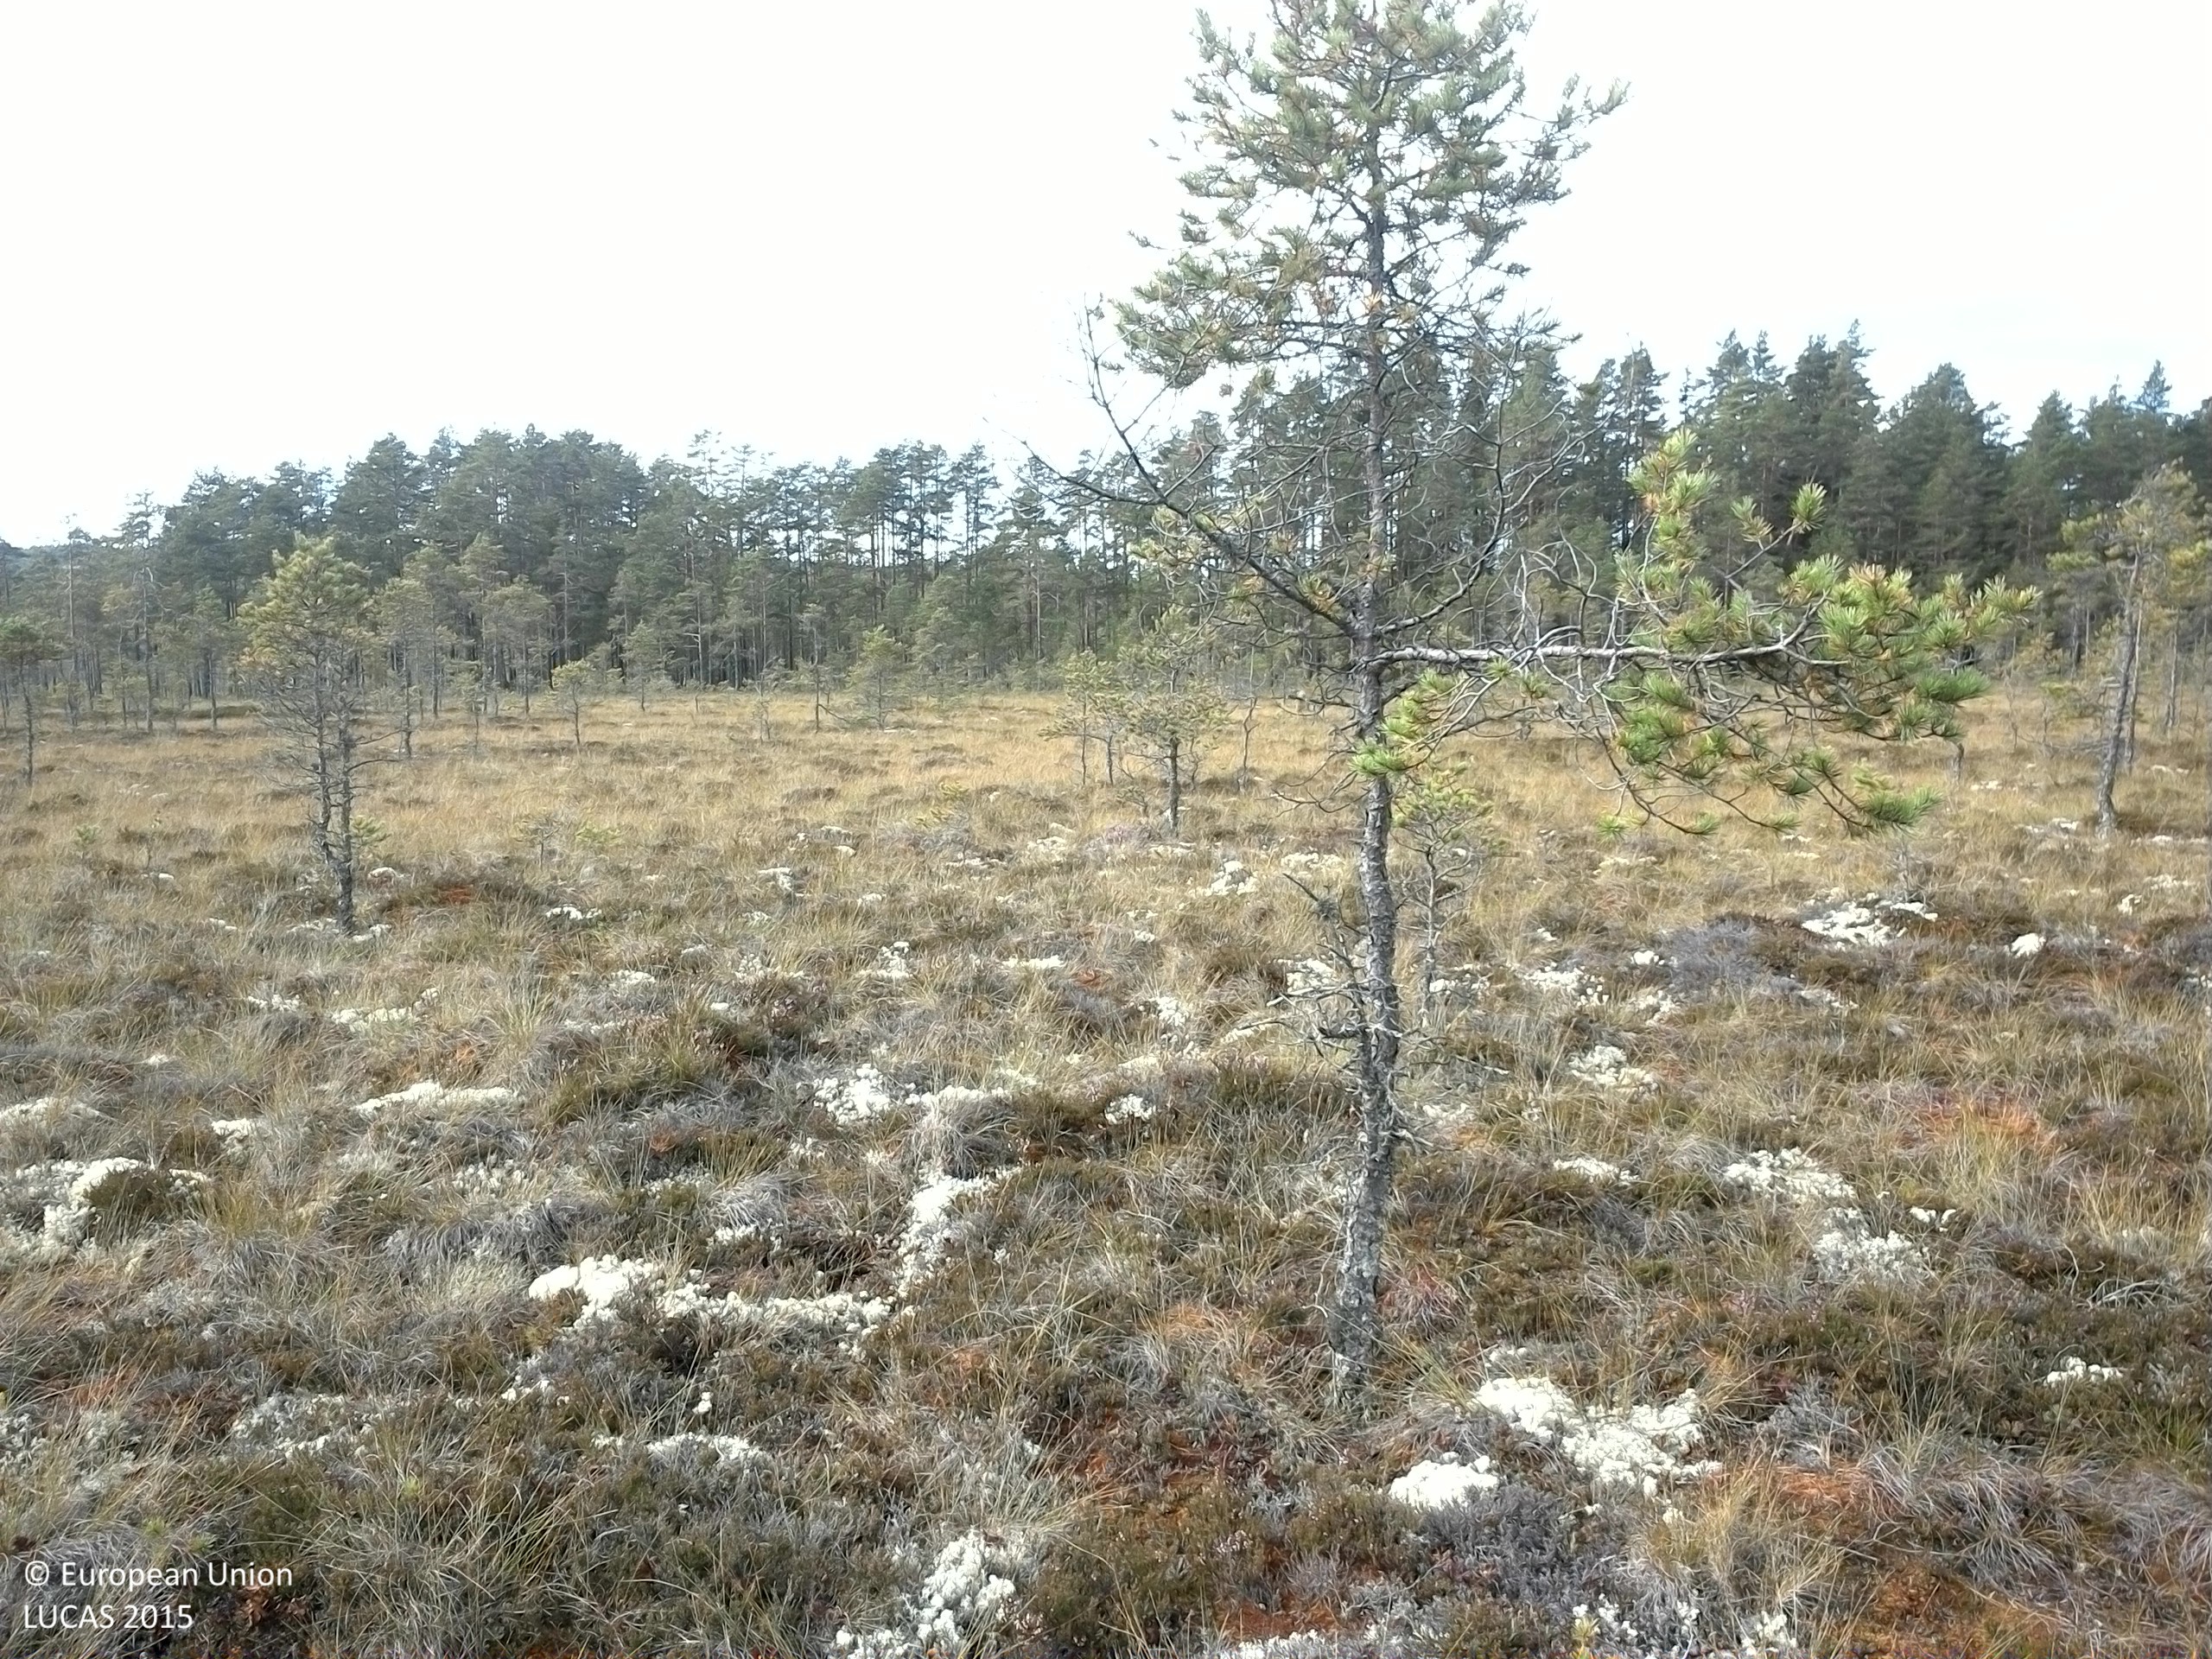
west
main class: Woodland
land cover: Pine dominated coniferous woodland
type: boreal forest
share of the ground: 10 - 25 %
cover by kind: shrubs 35 %, lichens and mosses 35 %, herbaceous plants 20 %, coniferous forest trees 10 %
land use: Semi-natural and natural areas not in use
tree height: < 5 m
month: September
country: SE
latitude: 59.9455
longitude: 13.2314
